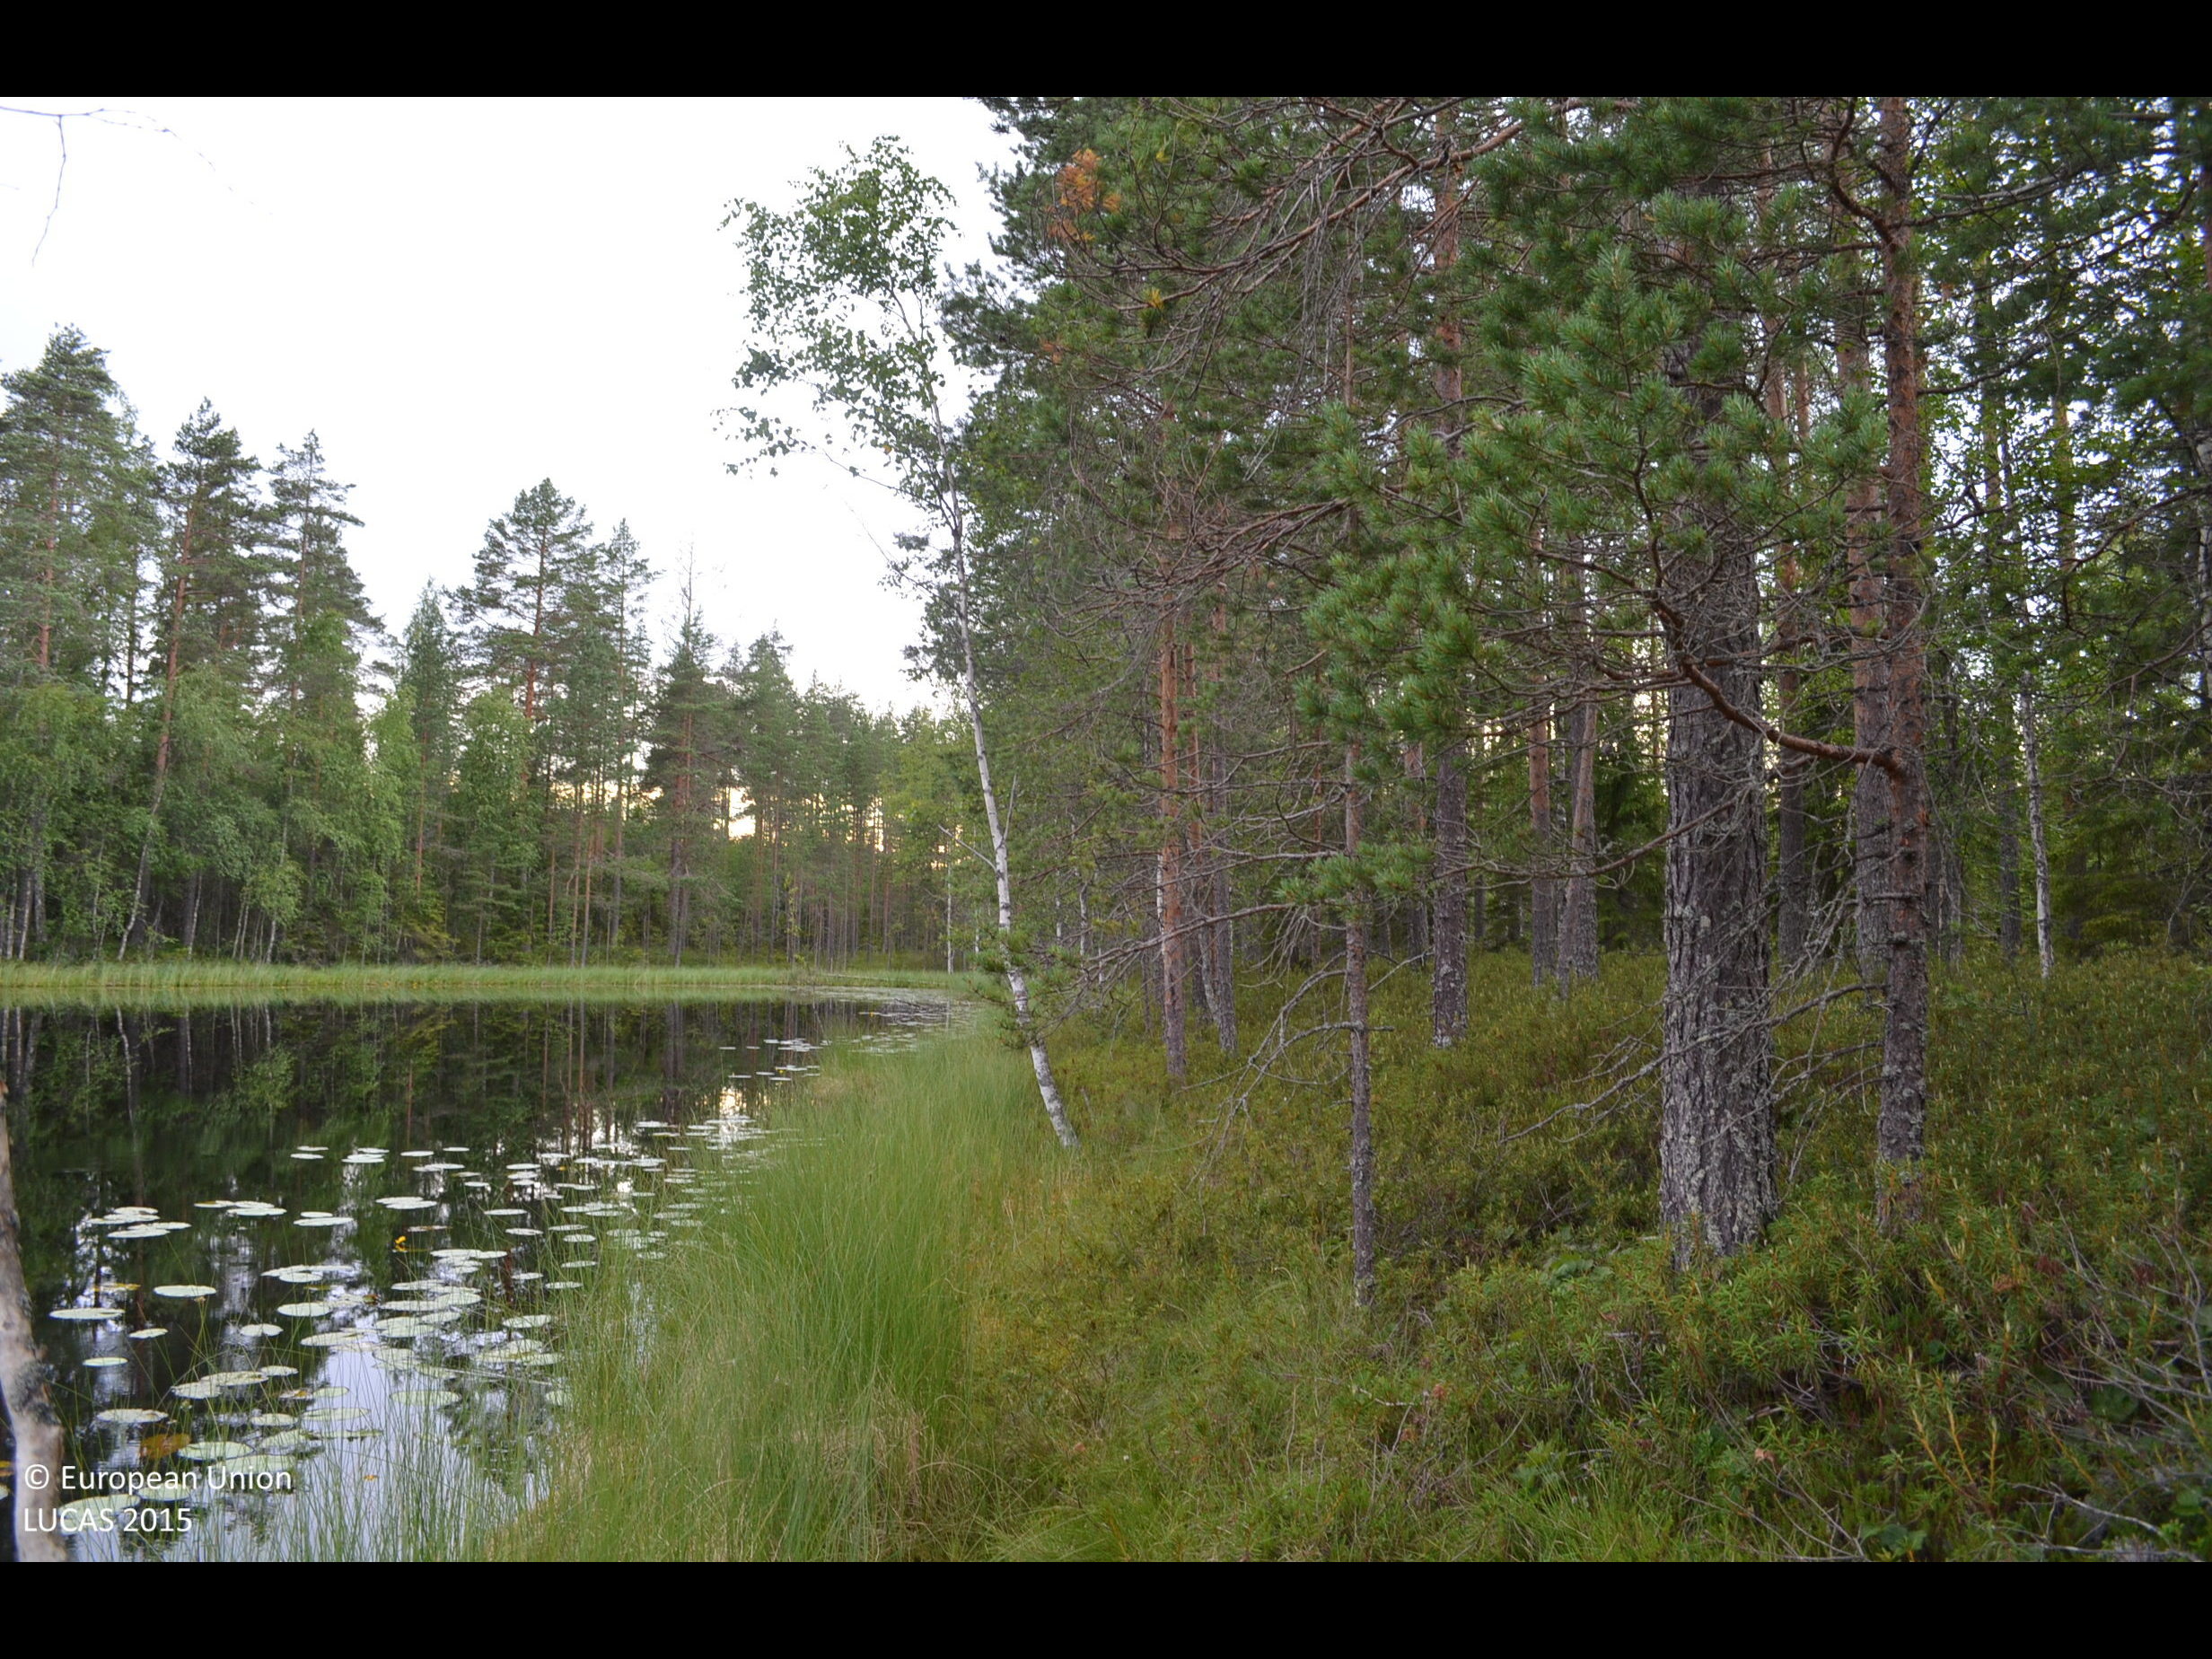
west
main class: Woodland
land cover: Pine dominated coniferous woodland
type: boreal forest
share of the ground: > 75 %
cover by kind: coniferous forest trees 65 %, shrubs 25 %, broadleaved forest trees 10 %
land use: Forestry
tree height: > 5 m
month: July
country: FI
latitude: 62.0294
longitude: 23.9783
